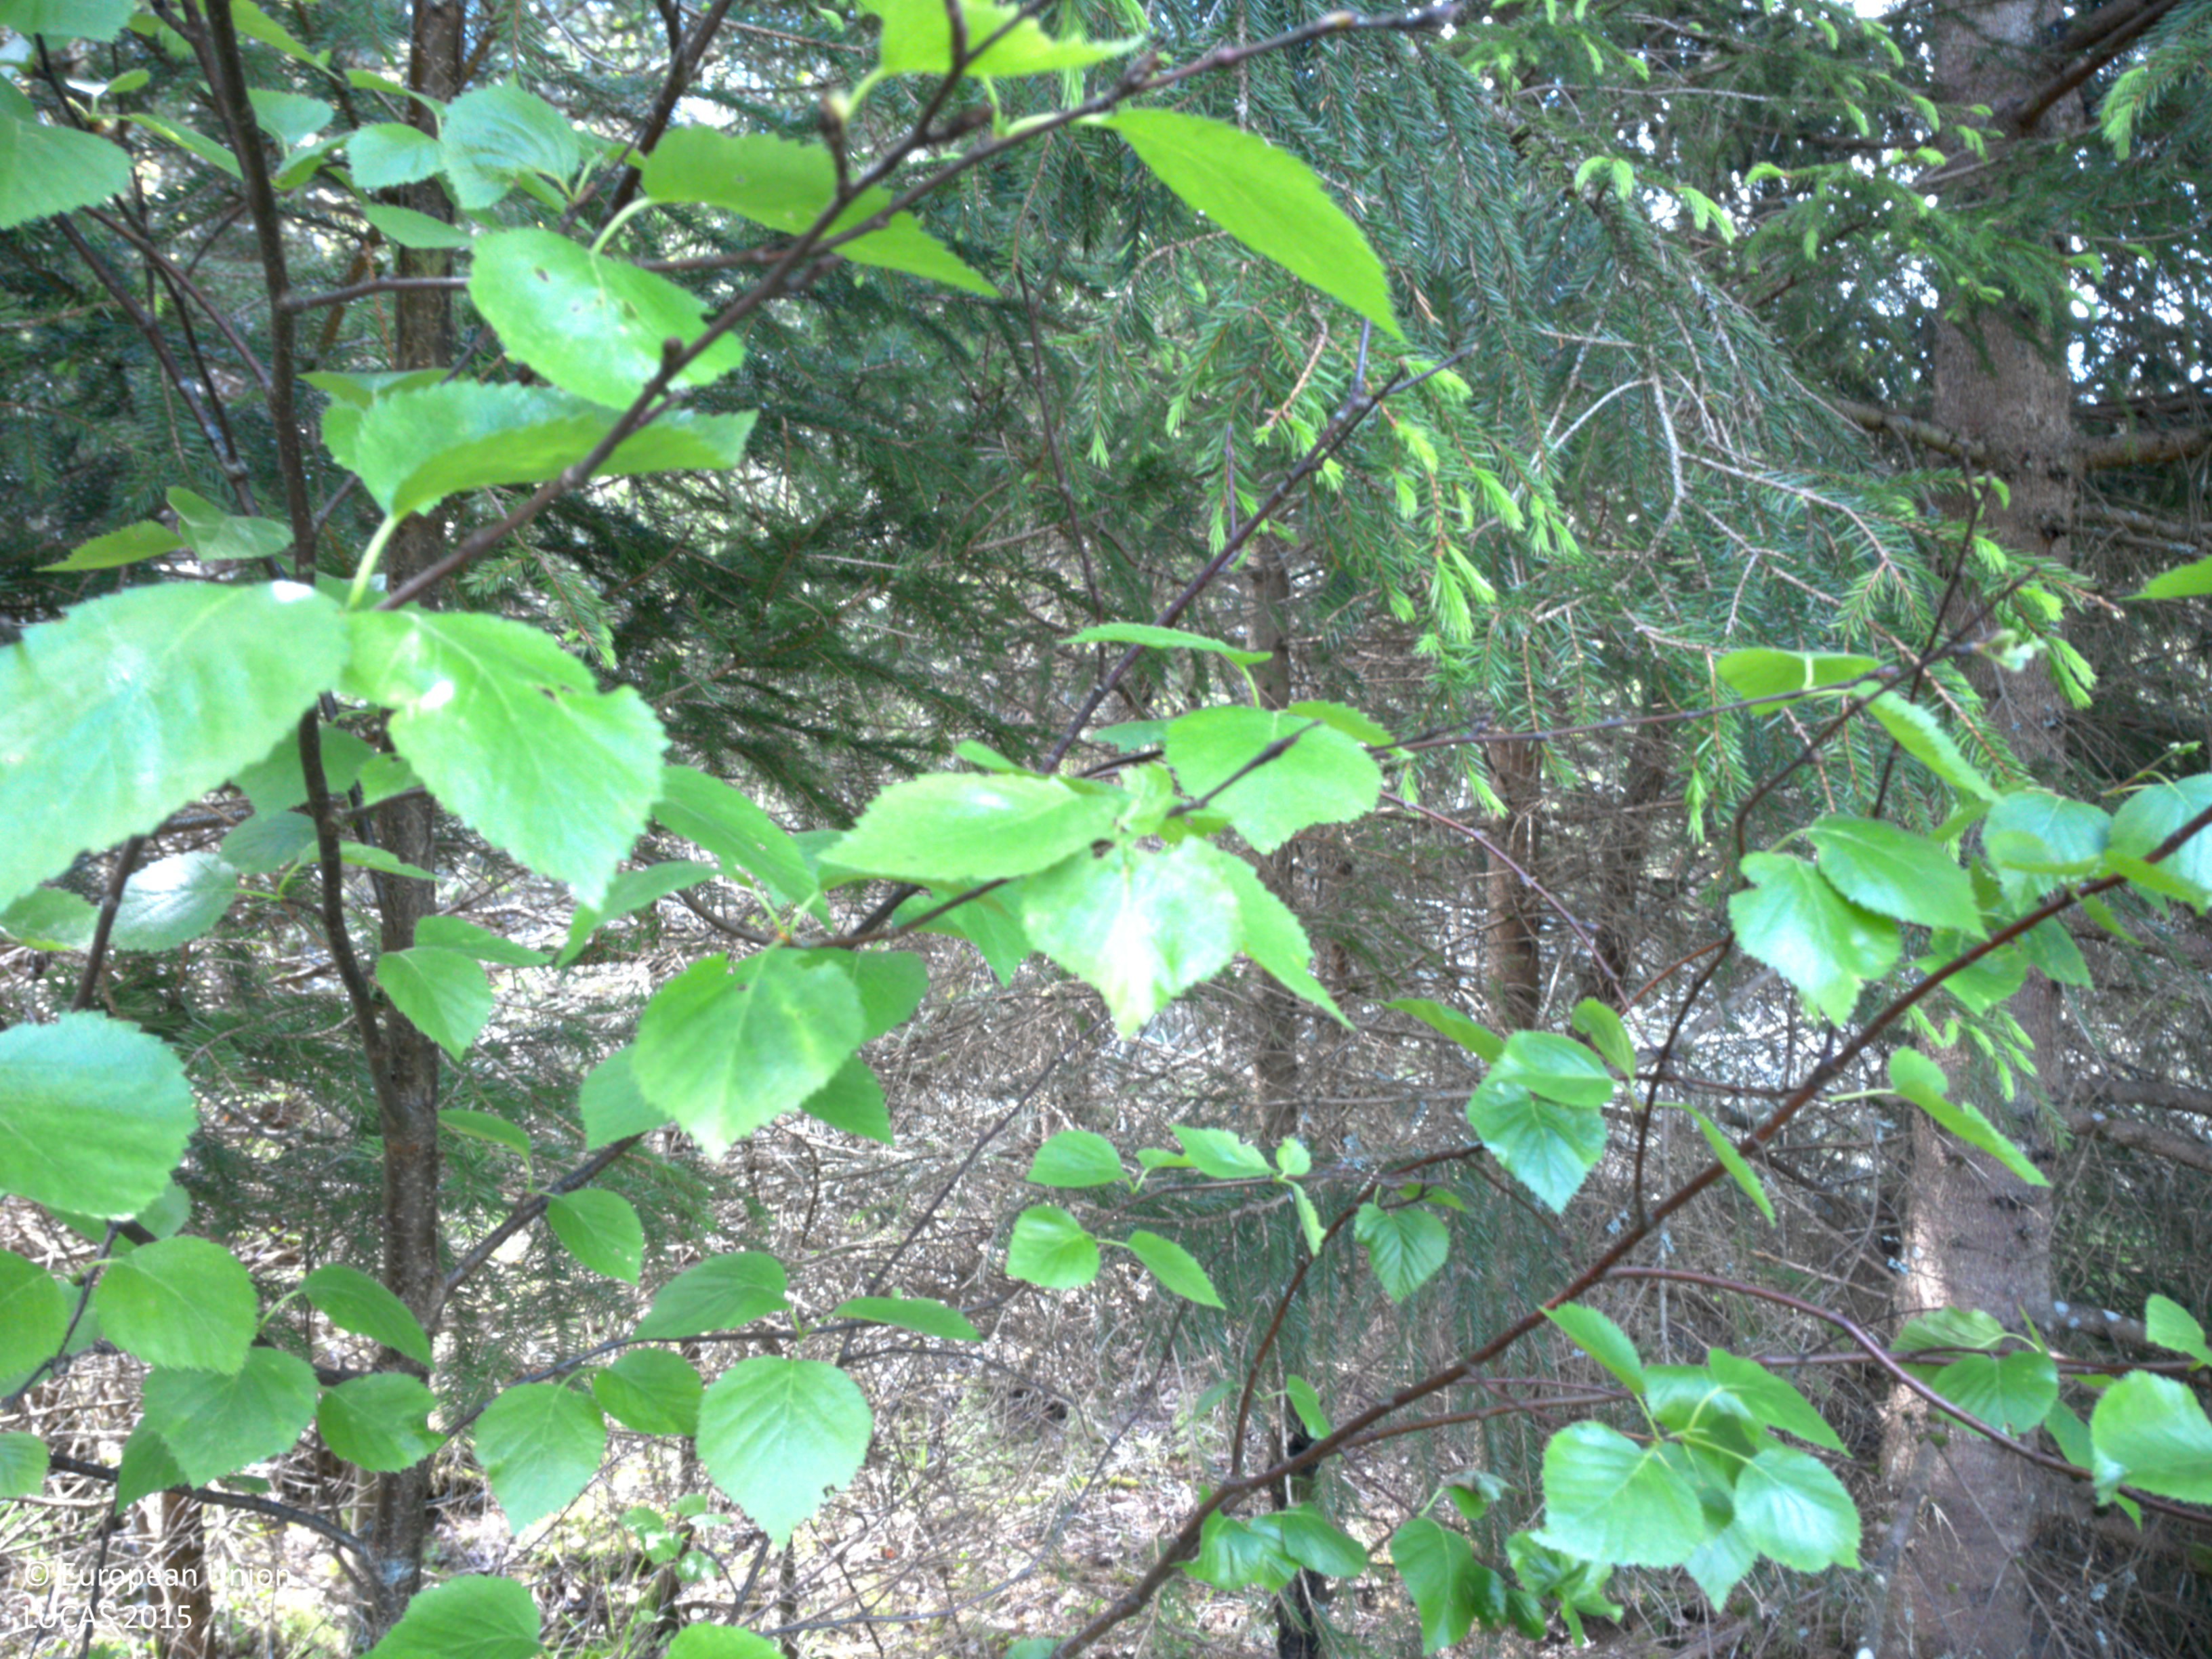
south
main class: Woodland
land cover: Spruce dominated mixed woodland
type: boreal forest
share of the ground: 25 - 50 %
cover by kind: herbaceous plants 50 %, coniferous forest trees 35 %, broadleaved forest trees 15 %
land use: Forestry
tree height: > 5 m
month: June
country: SE
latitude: 58.3137
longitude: 11.9250
